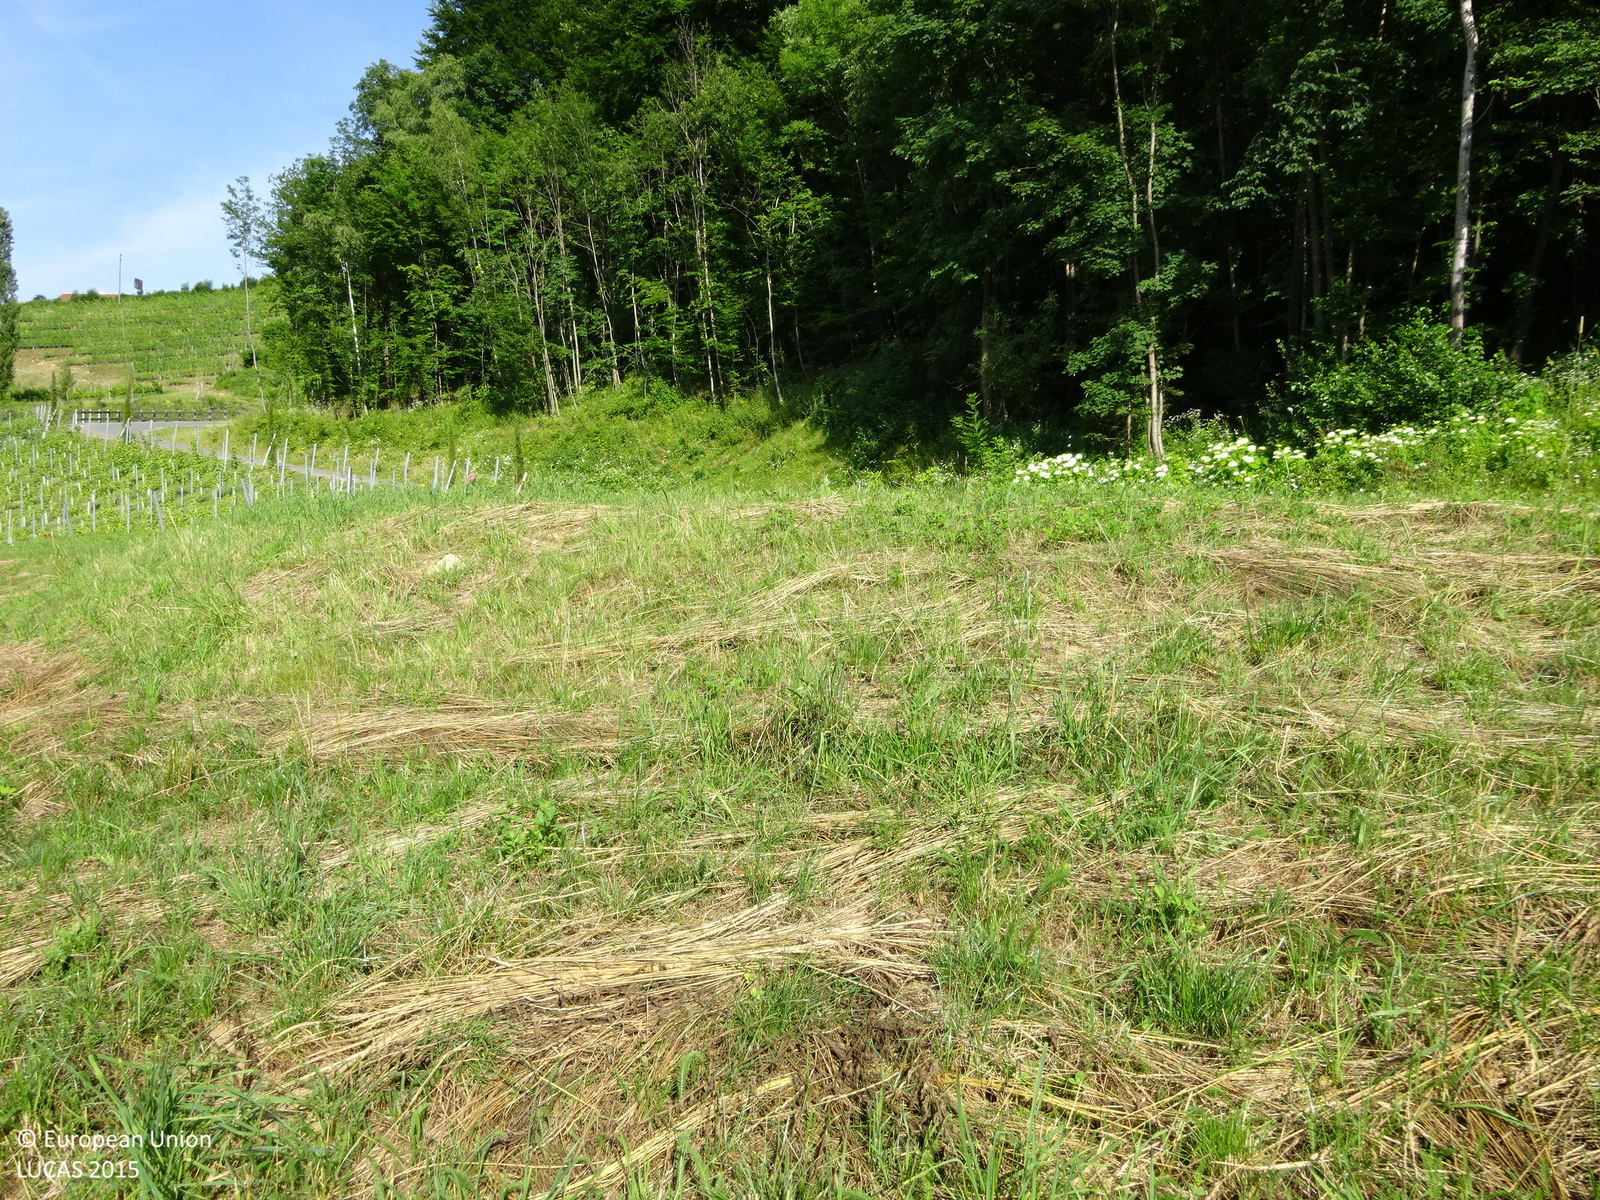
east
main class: Grassland
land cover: Grassland without tree/shrub cover
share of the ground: > 75 %
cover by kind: herbaceous plants 100 %
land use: Agriculture (excluding fallow land and kitchen gardens)
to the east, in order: Grassland without tree/shrub cover; Fences; Grassland without tree/shrub cover; Artificial constructions in urban areas; Grassland with sparse tree/shrub cover; Vineyards; Floriculture and ornamental plants; Broadleaved woodland; Grassland without tree/shrub cover; Rivers and streams; Shrubland with sparse tree cover; Broadleaved woodland; Conifer hedges; Tracks; Dry stone walls; Grassland with sparse tree/shrub cover; Electric lines; Paved roads, cycling and walking lanes; Grass margins; Abandoned hedges; Grassland without tree/shrub cover
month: June
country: AT
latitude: 46.6914
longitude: 15.6090
